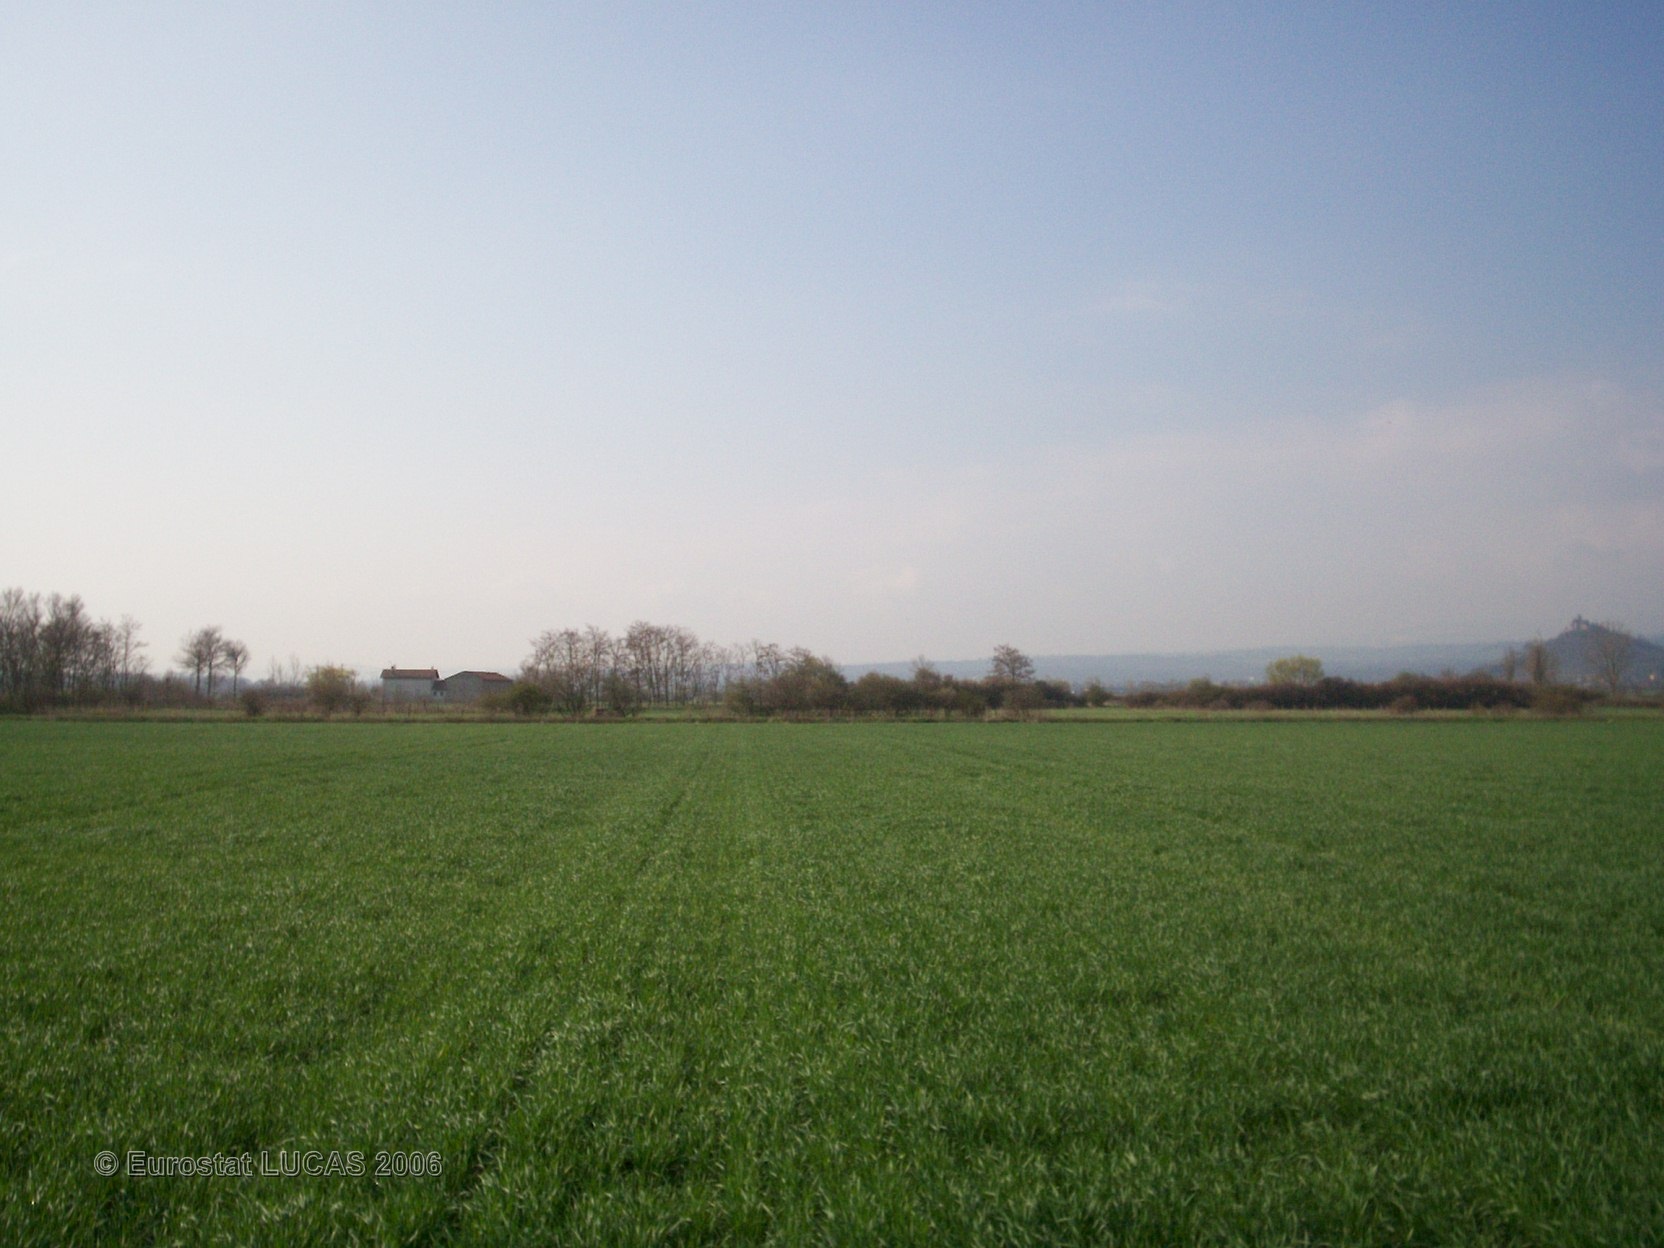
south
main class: Cropland
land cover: Common wheat
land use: Agriculture (excluding fallow land and kitchen gardens)
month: April
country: FR
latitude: 45.5768
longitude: 4.1465
